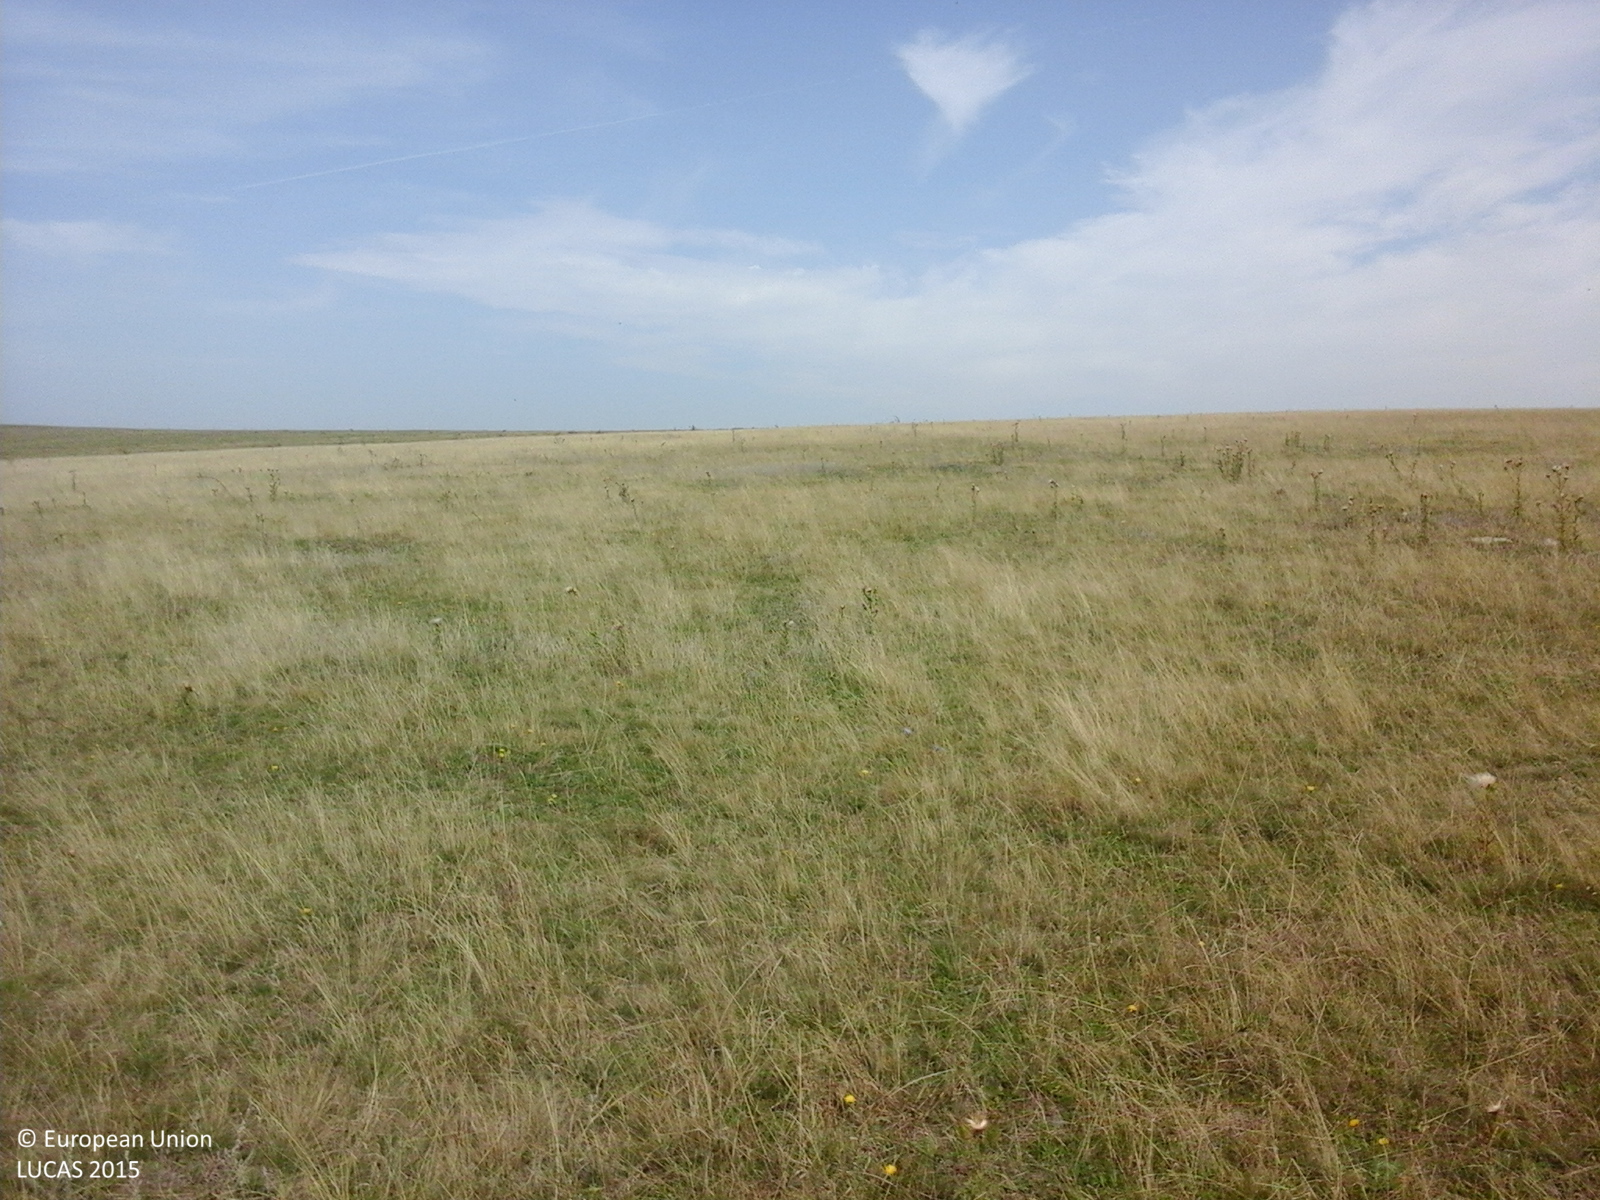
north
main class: Grassland
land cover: Grassland without tree/shrub cover
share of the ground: > 75 %
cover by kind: herbaceous plants 100 %
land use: Agriculture (excluding fallow land and kitchen gardens)
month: September
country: RO
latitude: 46.8156
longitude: 23.5570
